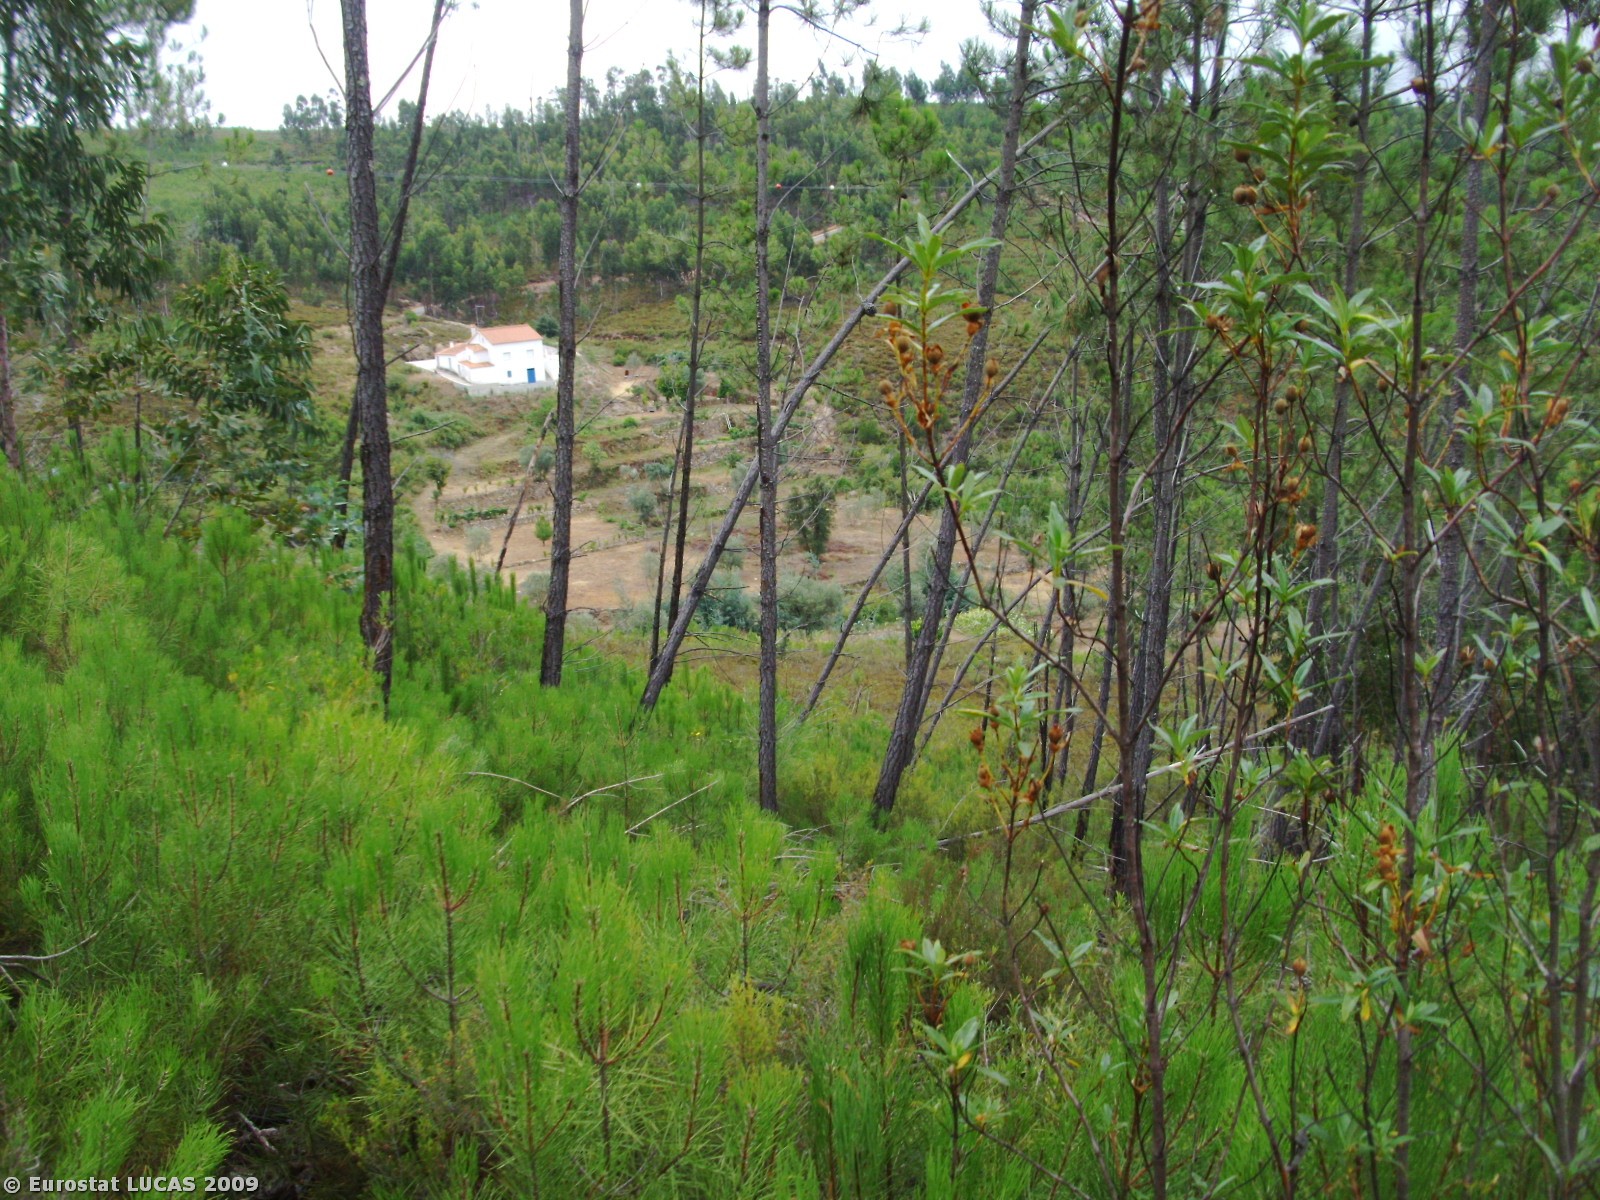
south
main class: Woodland
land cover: Coniferous woodland
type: coniferous forest of the mediterranean region
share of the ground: > 75 %
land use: Forestry
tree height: > 5 m
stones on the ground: > 50 %
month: July
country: PT
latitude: 39.6508
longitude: -8.1413
